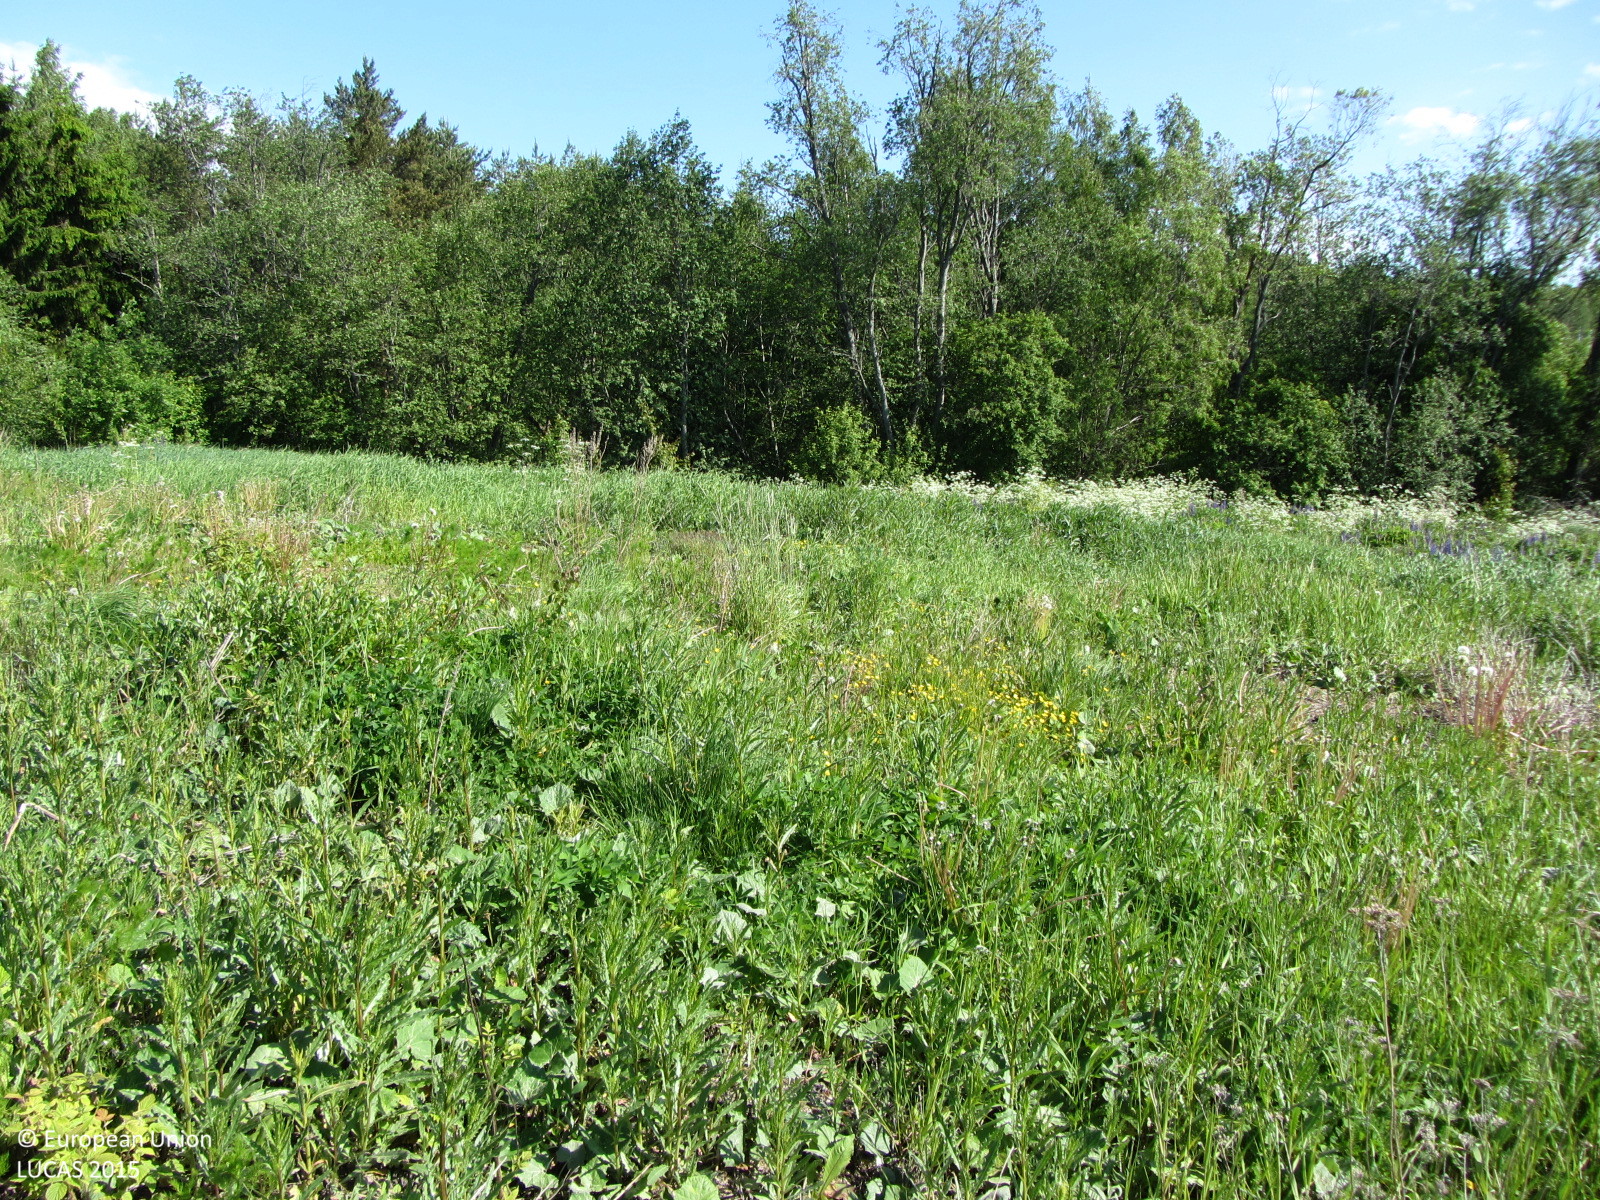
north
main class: Grassland
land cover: Grassland with sparse tree/shrub cover
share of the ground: > 75 %
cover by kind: herbaceous plants 90 %, broadleaved forest trees 5 %, unconsolidated bare surface 5 %
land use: Semi-natural and natural areas not in use
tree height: < 5 m
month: June
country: FI
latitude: 60.3815
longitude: 24.3063
